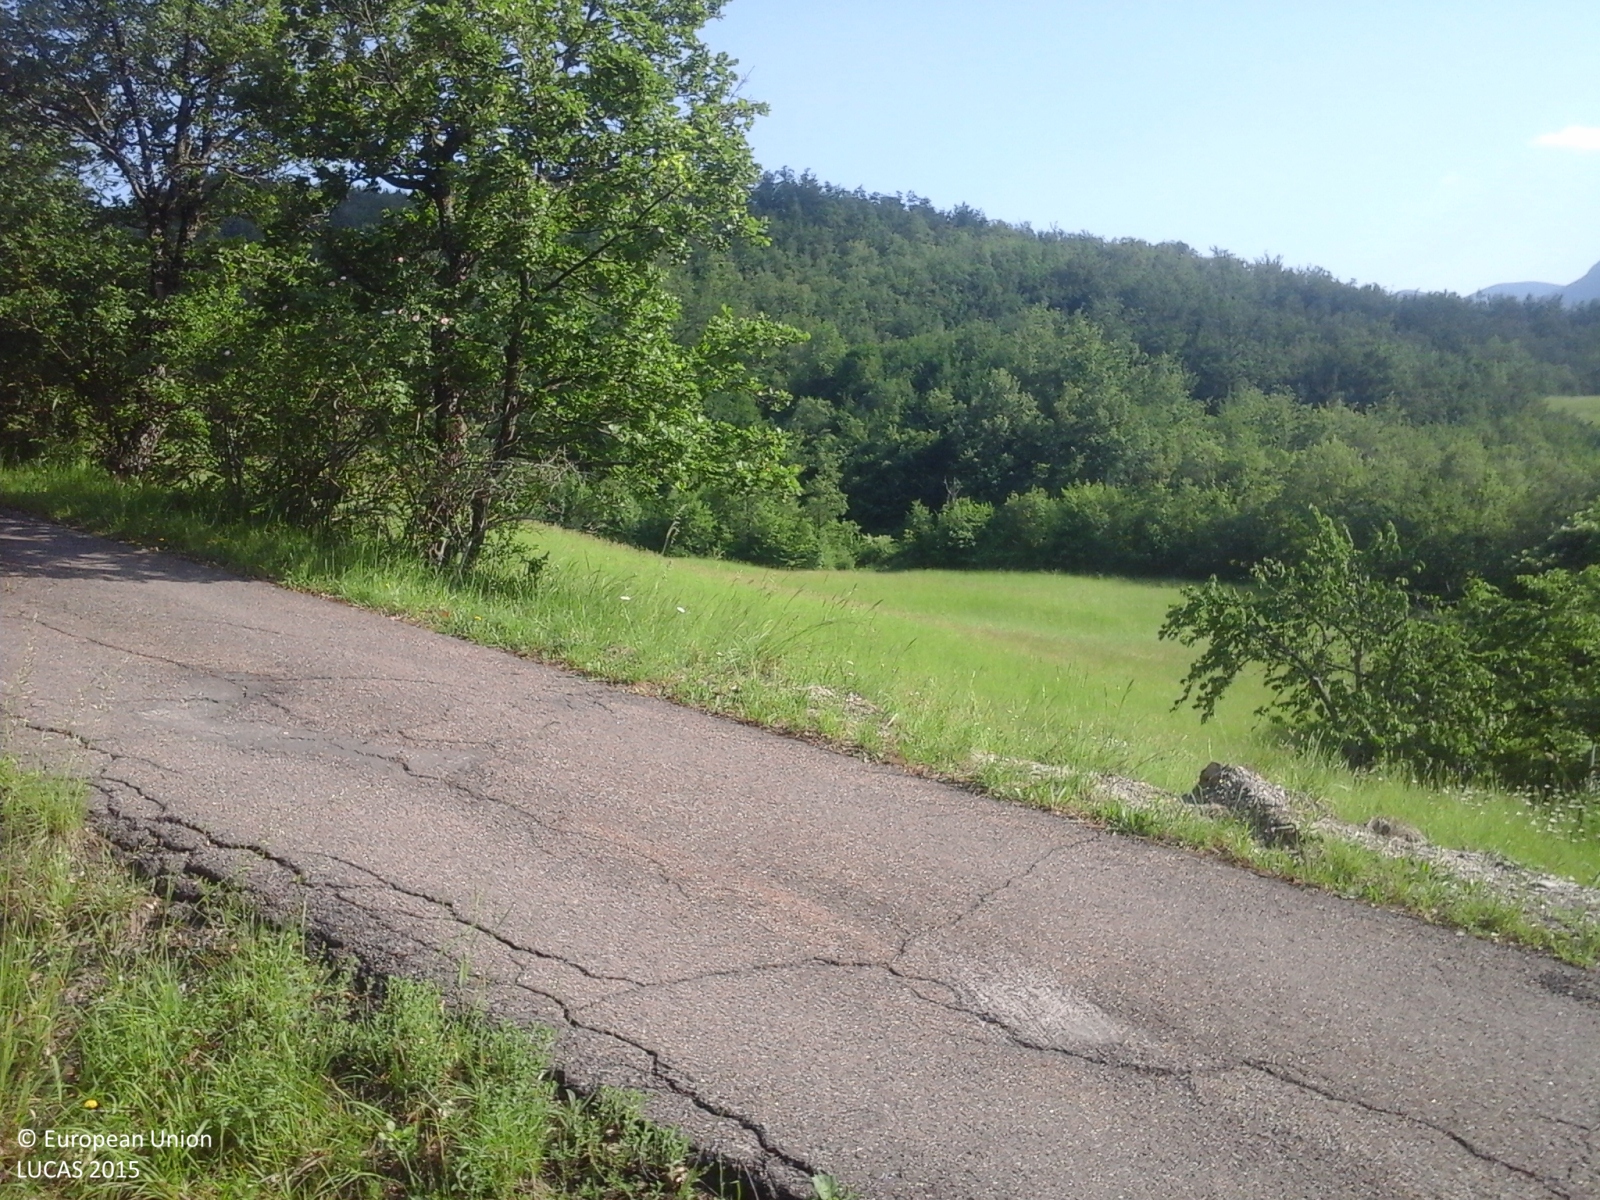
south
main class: Woodland
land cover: Broadleaved woodland
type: mesophytic deciduous forest
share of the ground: > 75 %
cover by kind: broadleaved forest trees 100 %
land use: Forestry
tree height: > 5 m
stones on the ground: 10 - 25 %
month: May
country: IT
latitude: 44.1662
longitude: 10.9107
